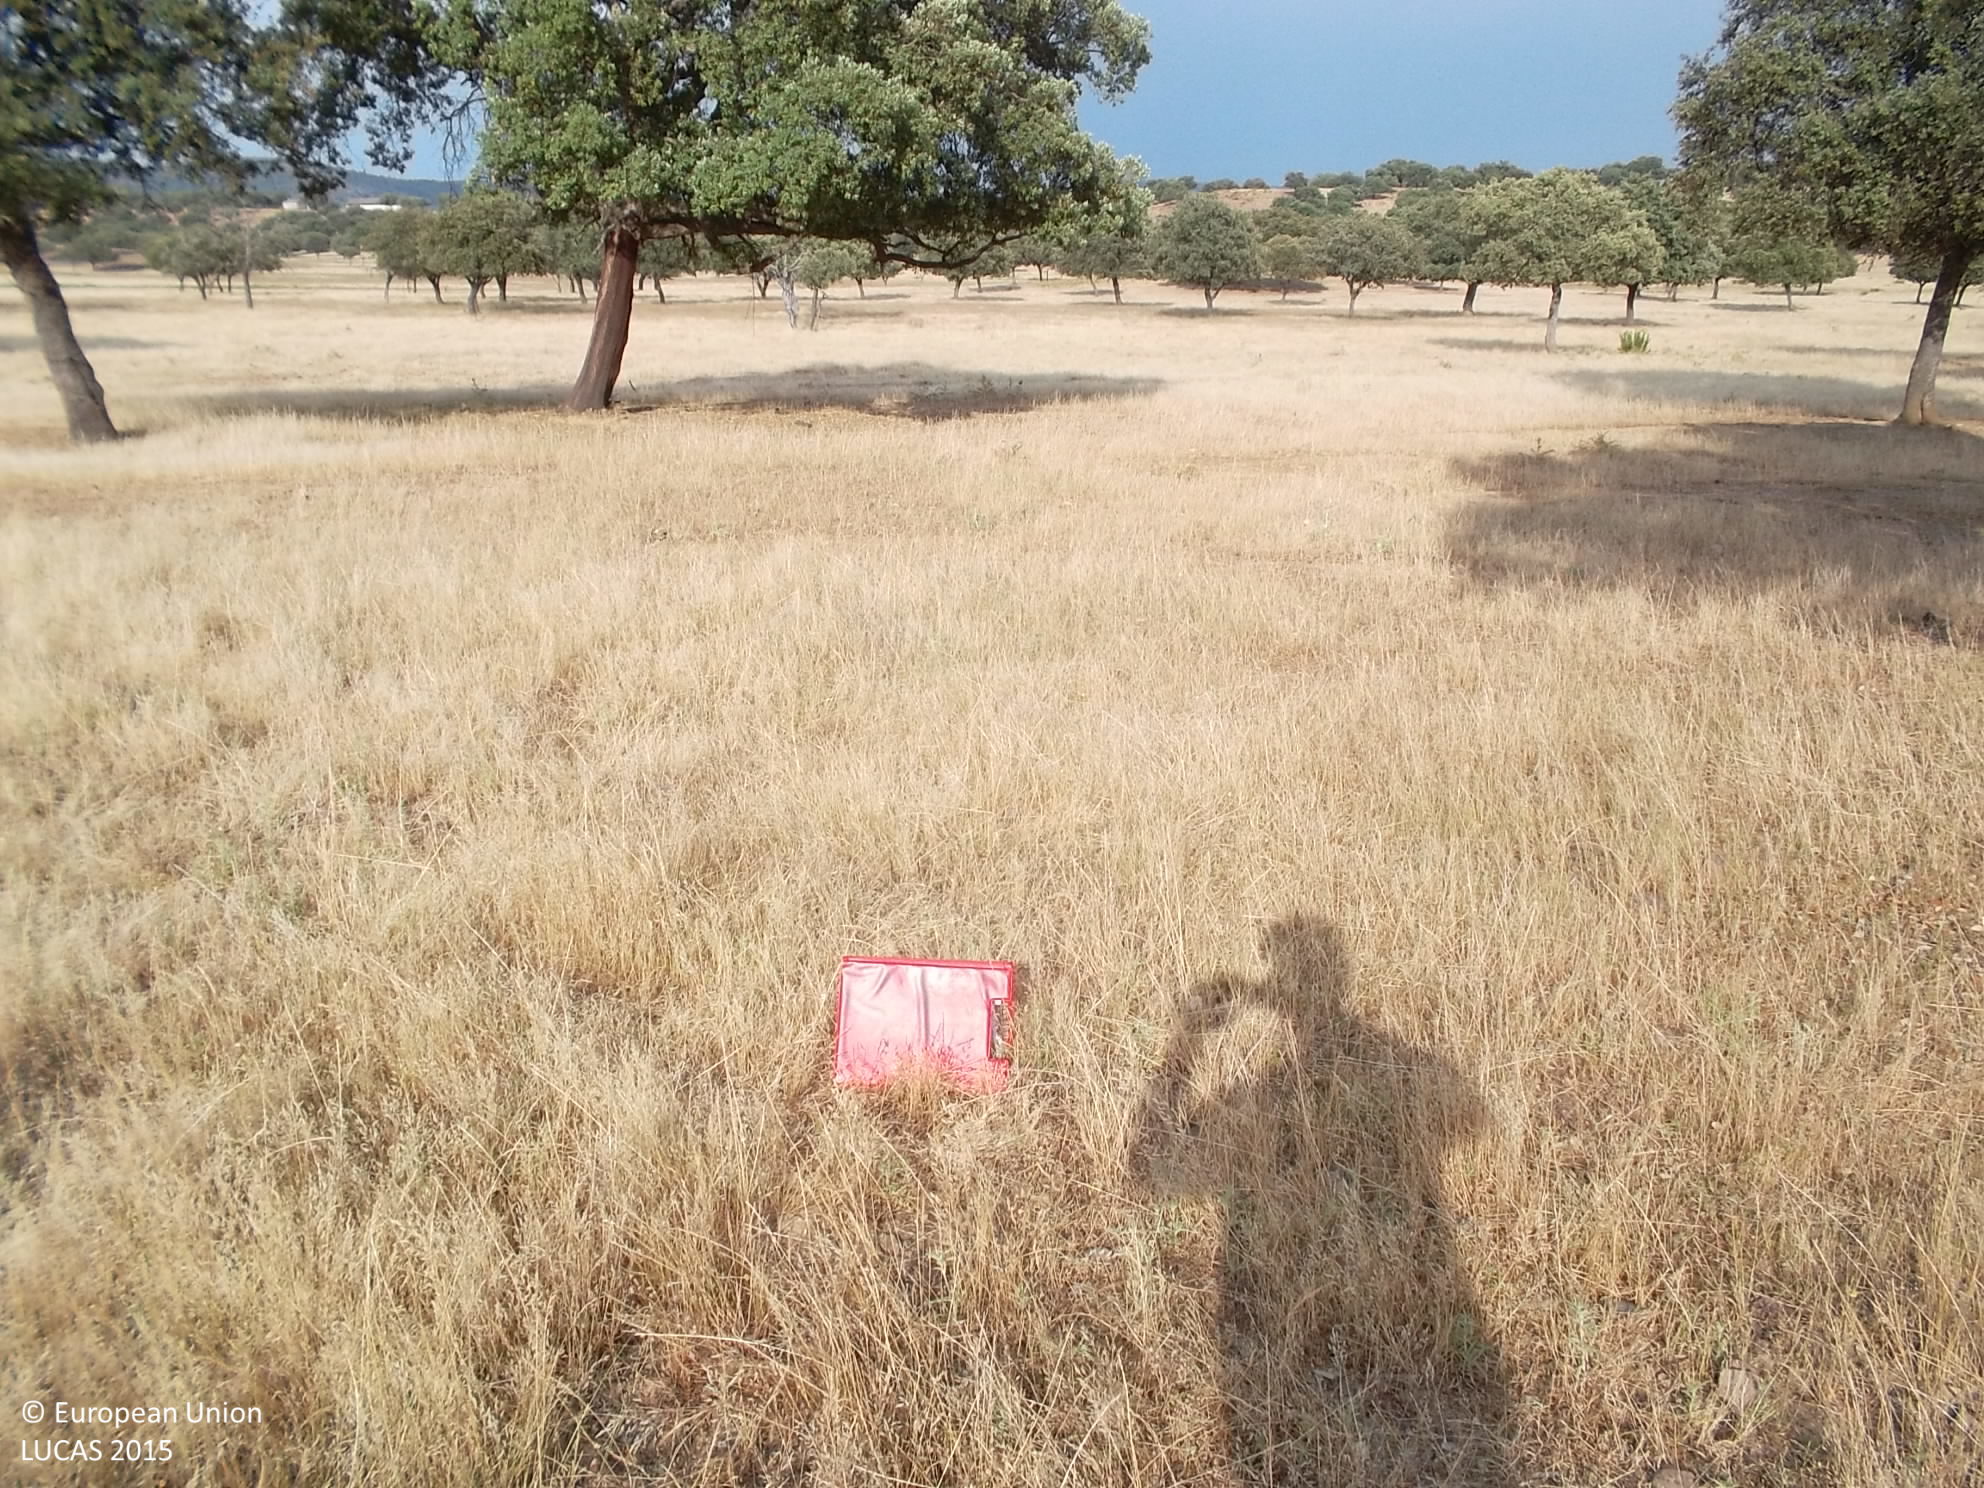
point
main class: Woodland
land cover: Broadleaved woodland
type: broadleaved evergreen forest
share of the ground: 25 - 50 %
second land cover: Spontaneously vegetated surfaces
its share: > 75 %
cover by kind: herbaceous plants 60 %, broadleaved forest trees 40 %
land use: Forestry
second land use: Agriculture (excluding fallow land and kitchen gardens)
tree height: > 5 m
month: June
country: ES
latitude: 39.2467
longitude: -4.9278
